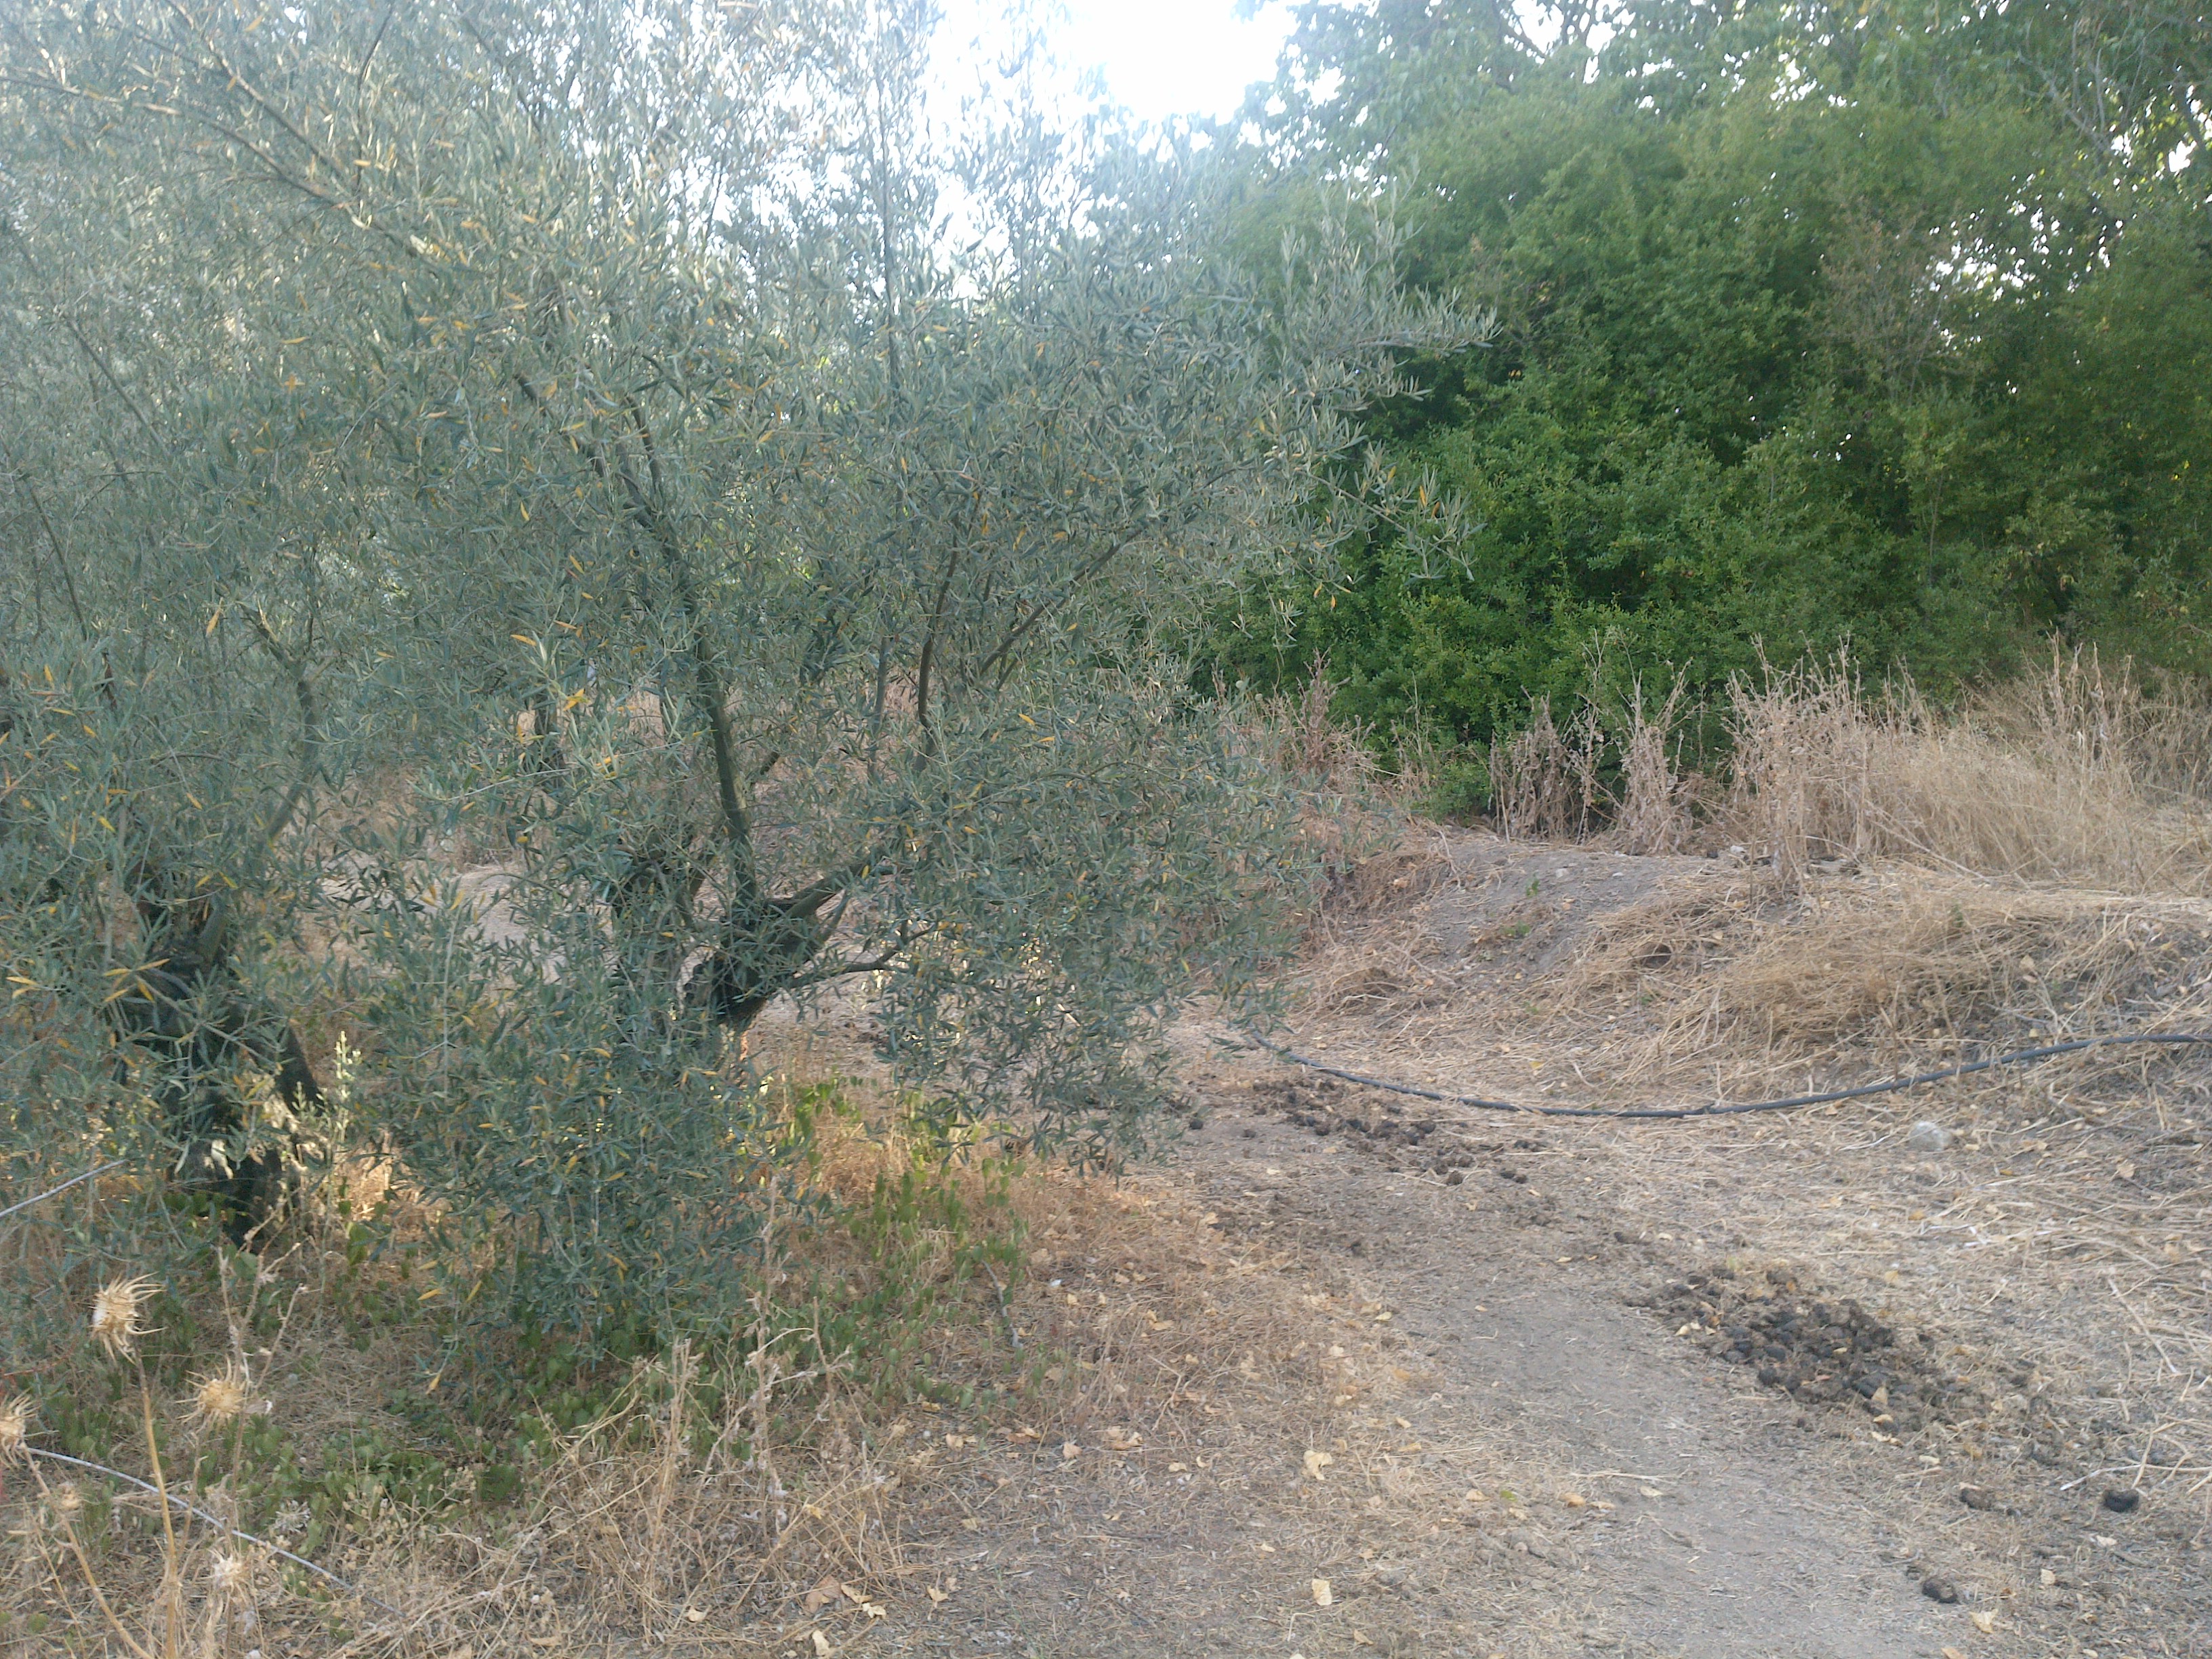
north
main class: Cropland
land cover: Olive groves
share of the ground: 50 - 75 %
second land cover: Spontaneously vegetated surfaces
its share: 10 - 25 %
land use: Agriculture (excluding fallow land and kitchen gardens)
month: July
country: ES
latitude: 37.3739
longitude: -4.4447
